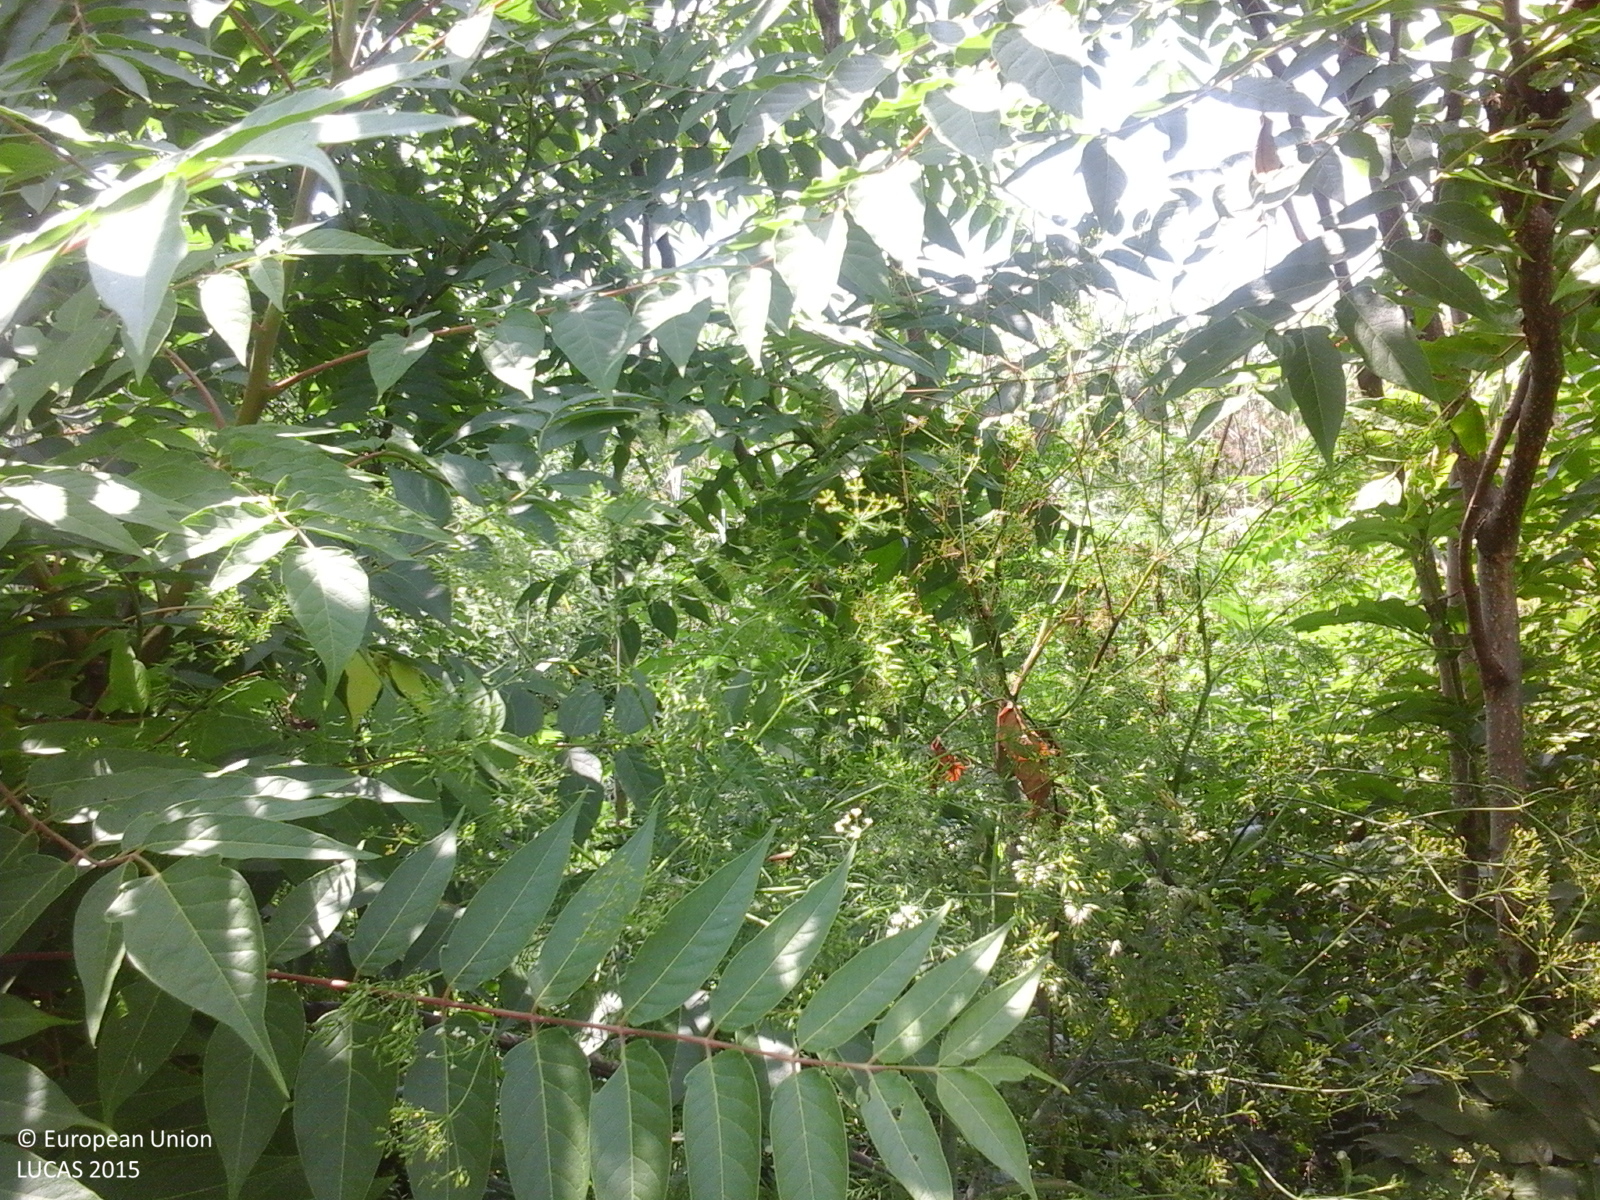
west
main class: Shrubland
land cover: Shrubland with sparse tree cover
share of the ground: > 75 %
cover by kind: shrubs 95 %, broadleaved forest trees 5 %
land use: Semi-natural and natural areas not in use
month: July
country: RO
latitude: 43.8727
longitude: 25.0210
